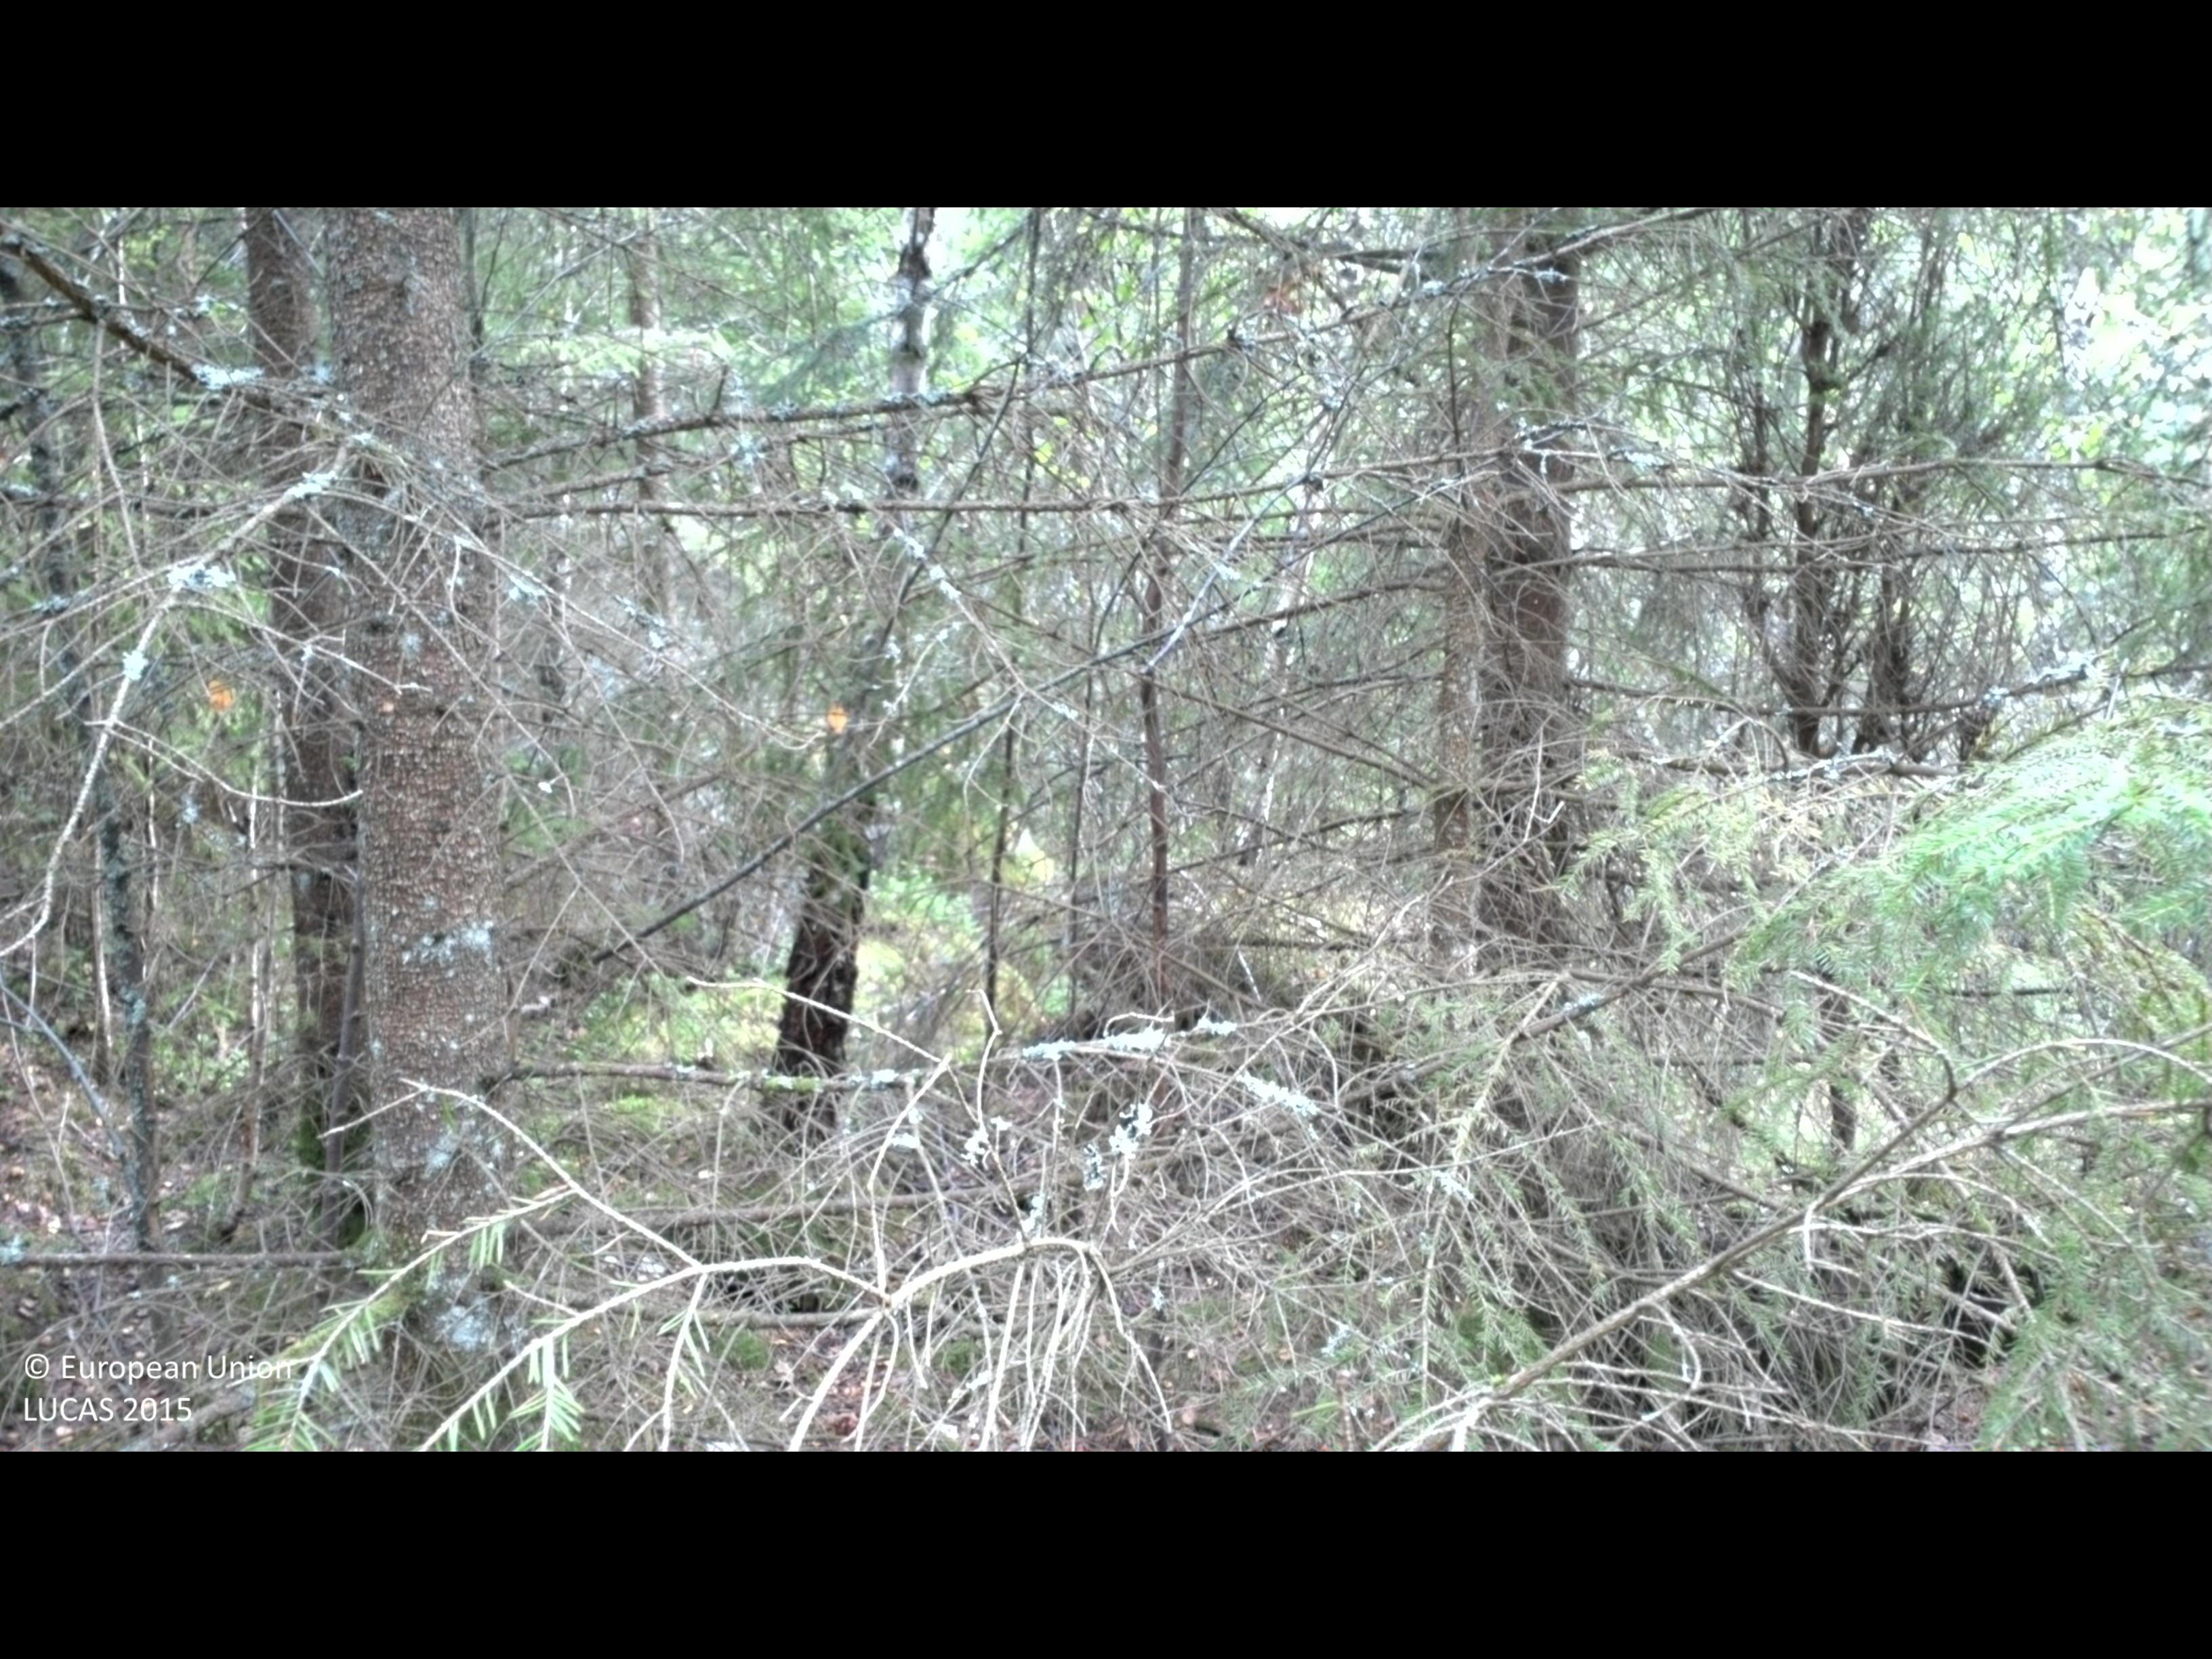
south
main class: Woodland
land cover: Spruce dominated mixed woodland
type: boreal forest
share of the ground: > 75 %
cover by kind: coniferous forest trees 55 %, broadleaved forest trees 25 %, lichens and mosses 20 %
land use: Forestry
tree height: > 5 m
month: August
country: SE
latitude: 56.3235
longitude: 15.0274
